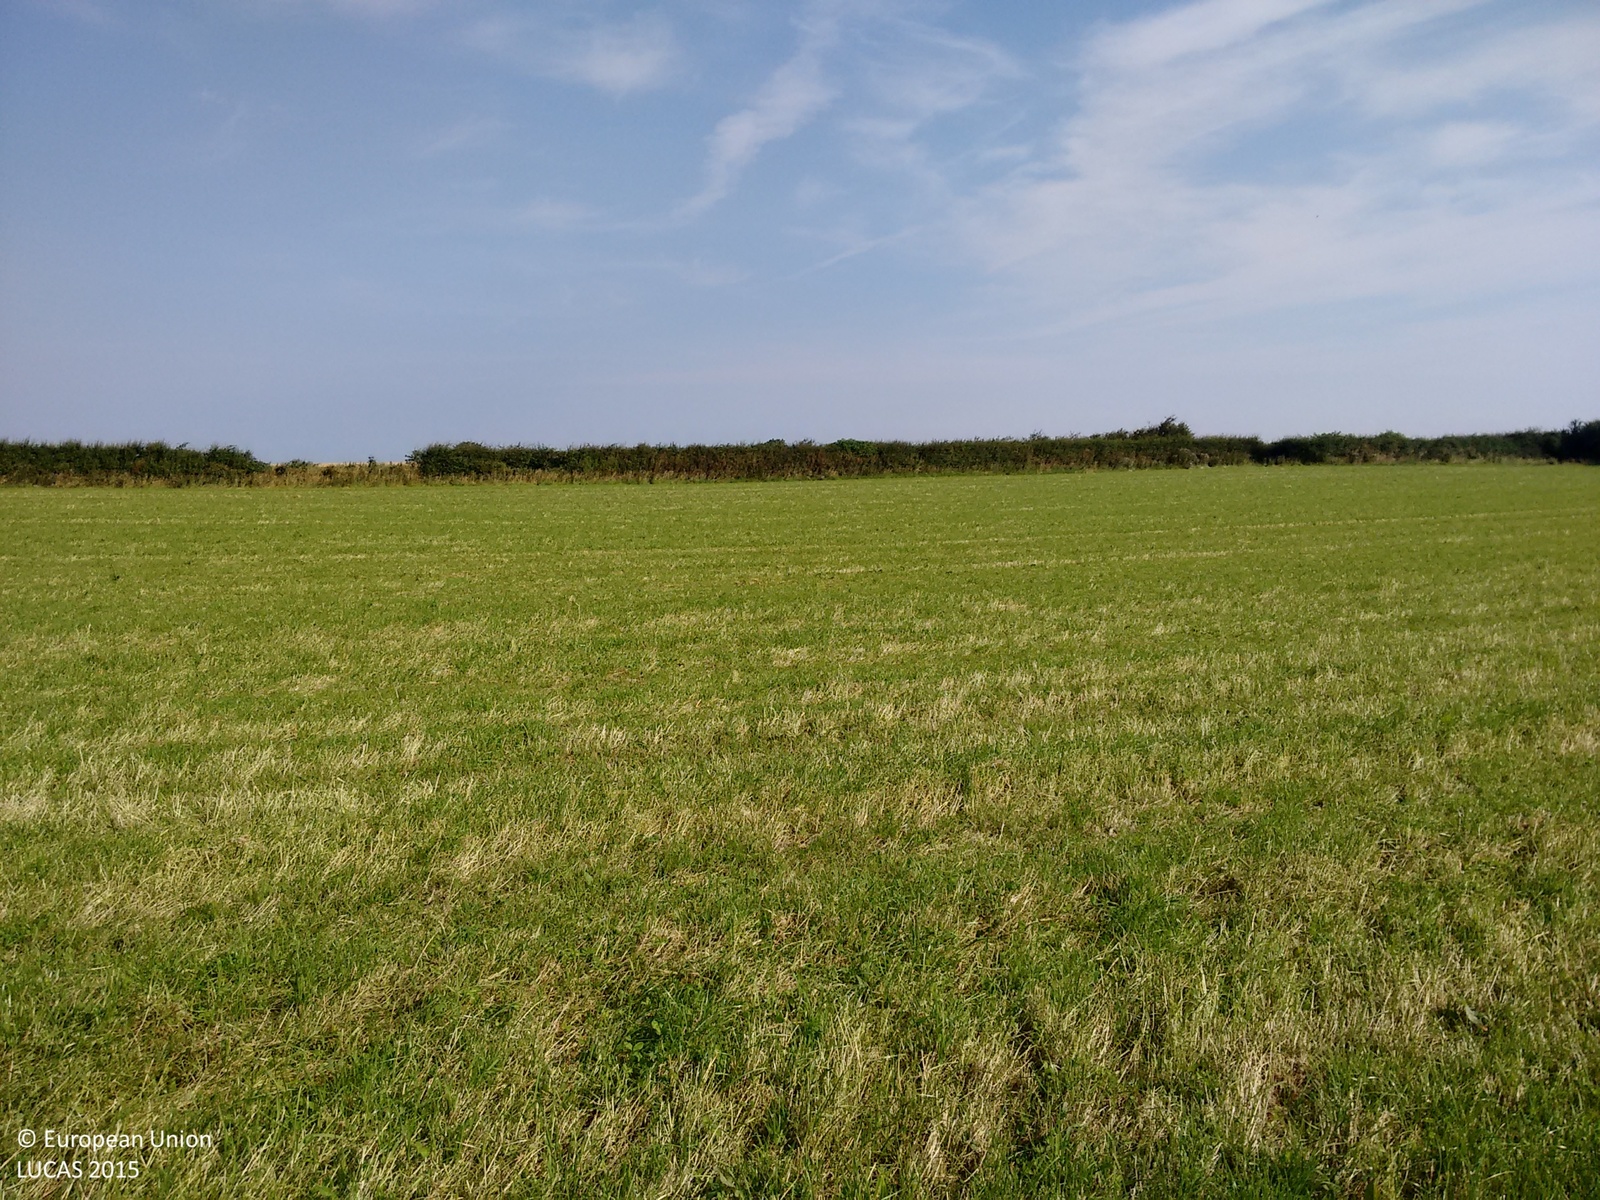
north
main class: Cropland
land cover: Temporary grasslands
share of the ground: > 75 %
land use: Agriculture (excluding fallow land and kitchen gardens)
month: August
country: GB
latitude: 54.8382
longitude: -3.2646
